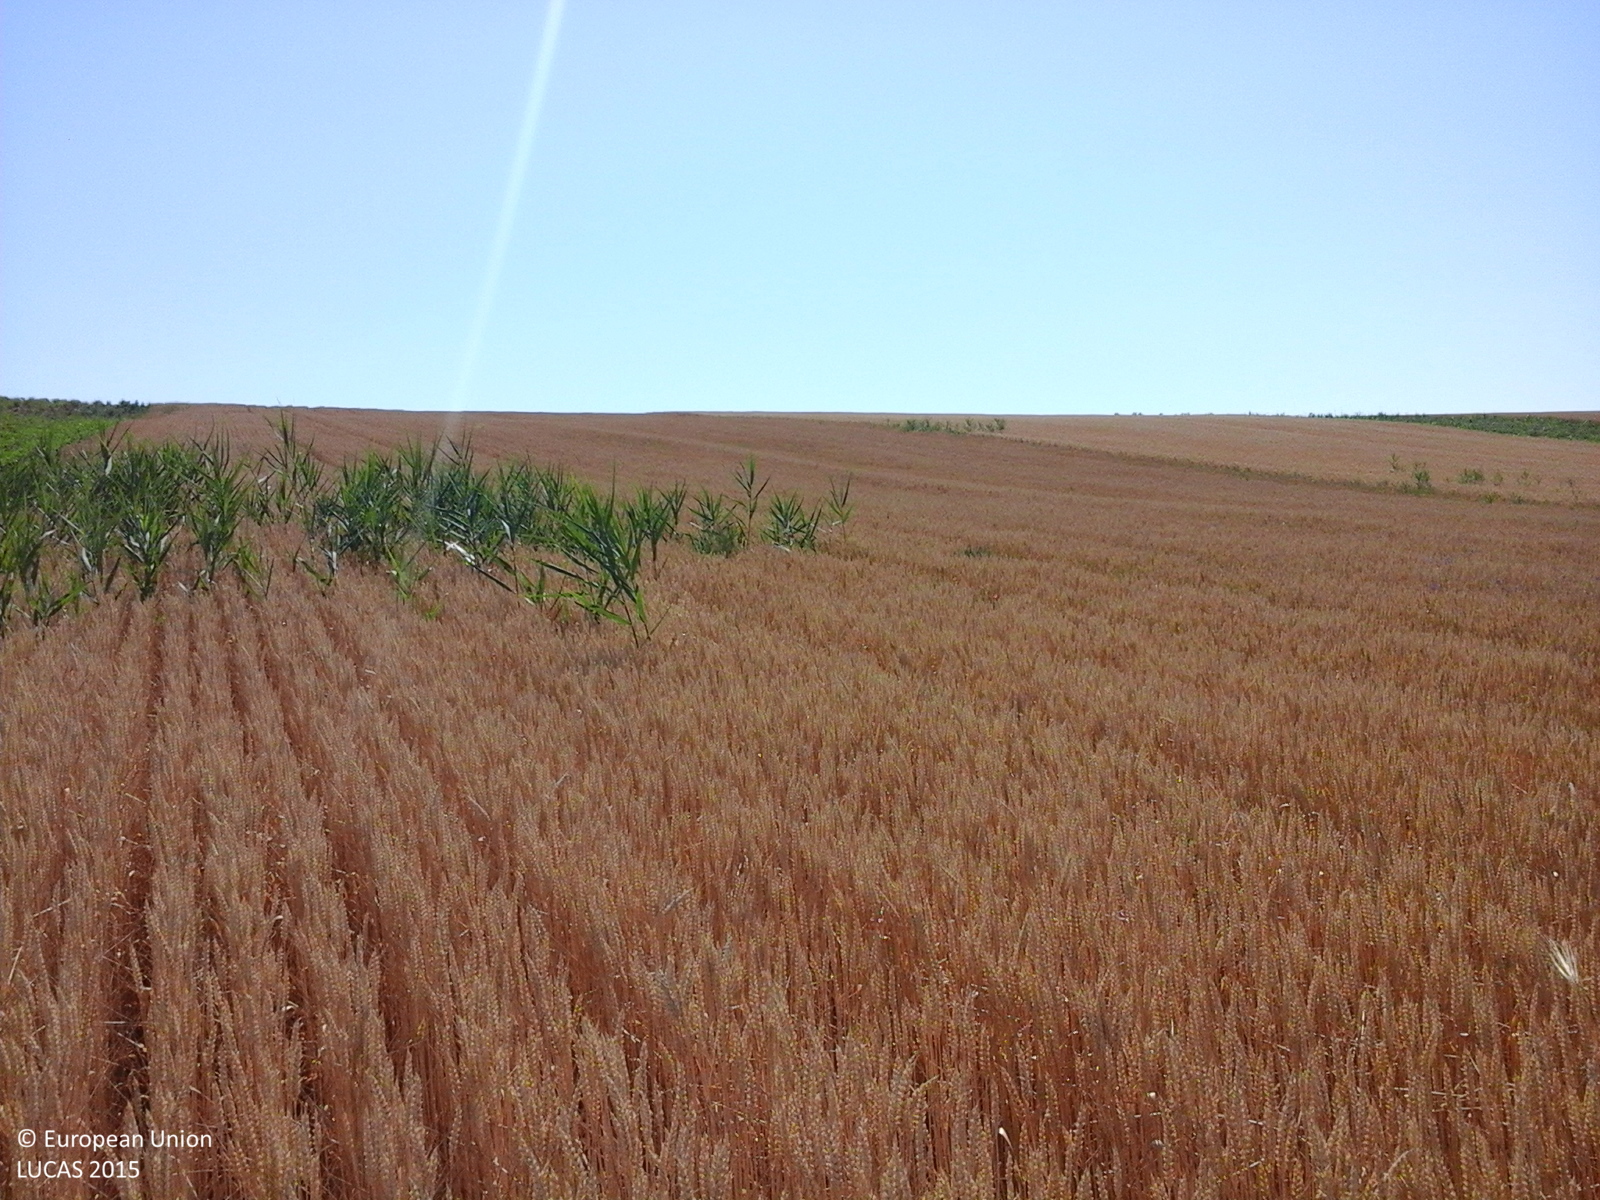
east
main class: Cropland
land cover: Common wheat
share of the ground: > 75 %
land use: Agriculture (excluding fallow land and kitchen gardens)
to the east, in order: Common wheat
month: June
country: RO
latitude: 47.2501
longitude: 27.1639
